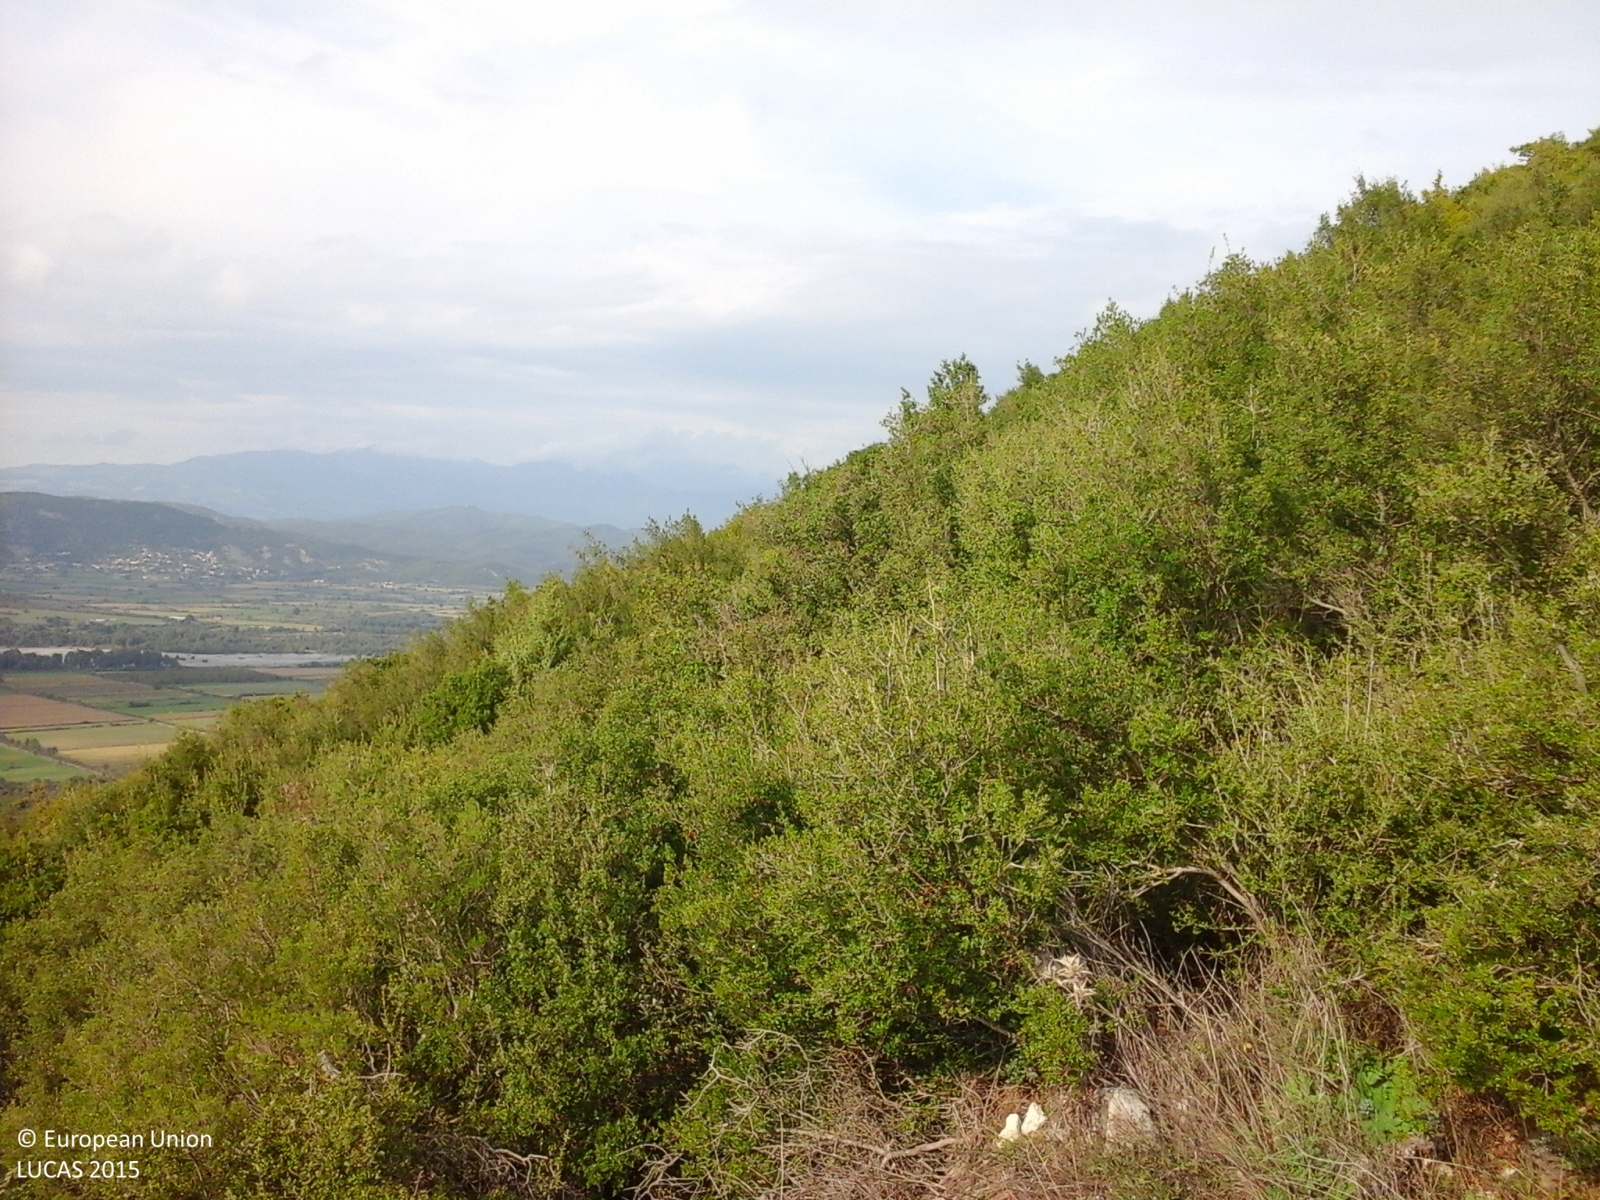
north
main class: Woodland
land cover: Broadleaved woodland
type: broadleaved evergreen forest
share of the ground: > 75 %
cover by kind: broadleaved forest trees 90 %, shrubs 10 %
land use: Forestry
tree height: > 5 m
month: October
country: GR
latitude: 39.9933
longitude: 20.6740
